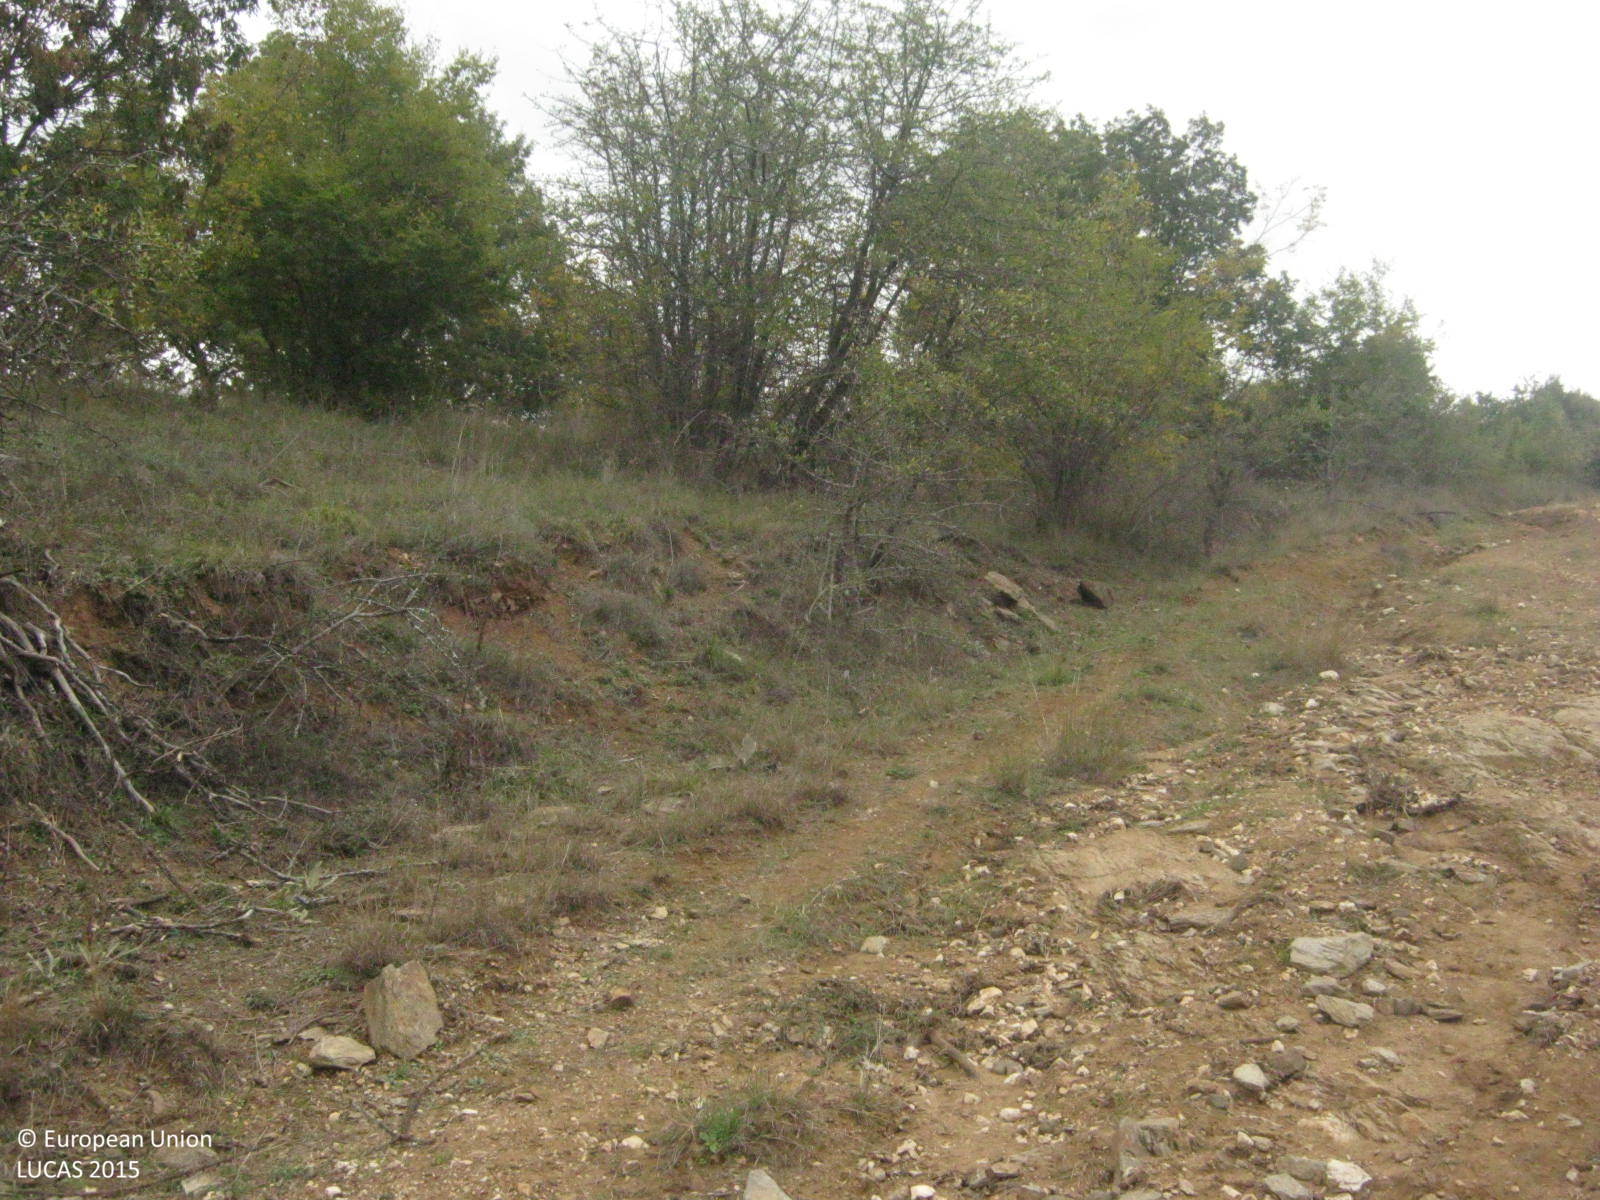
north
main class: Woodland
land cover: Broadleaved woodland
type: thermophilous deciduous forest
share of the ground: > 75 %
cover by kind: broadleaved forest trees 75 %, unconsolidated bare surface 20 %, shrubs 5 %
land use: Forestry
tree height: > 5 m
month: October
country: GR
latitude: 41.0009
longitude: 23.0545
